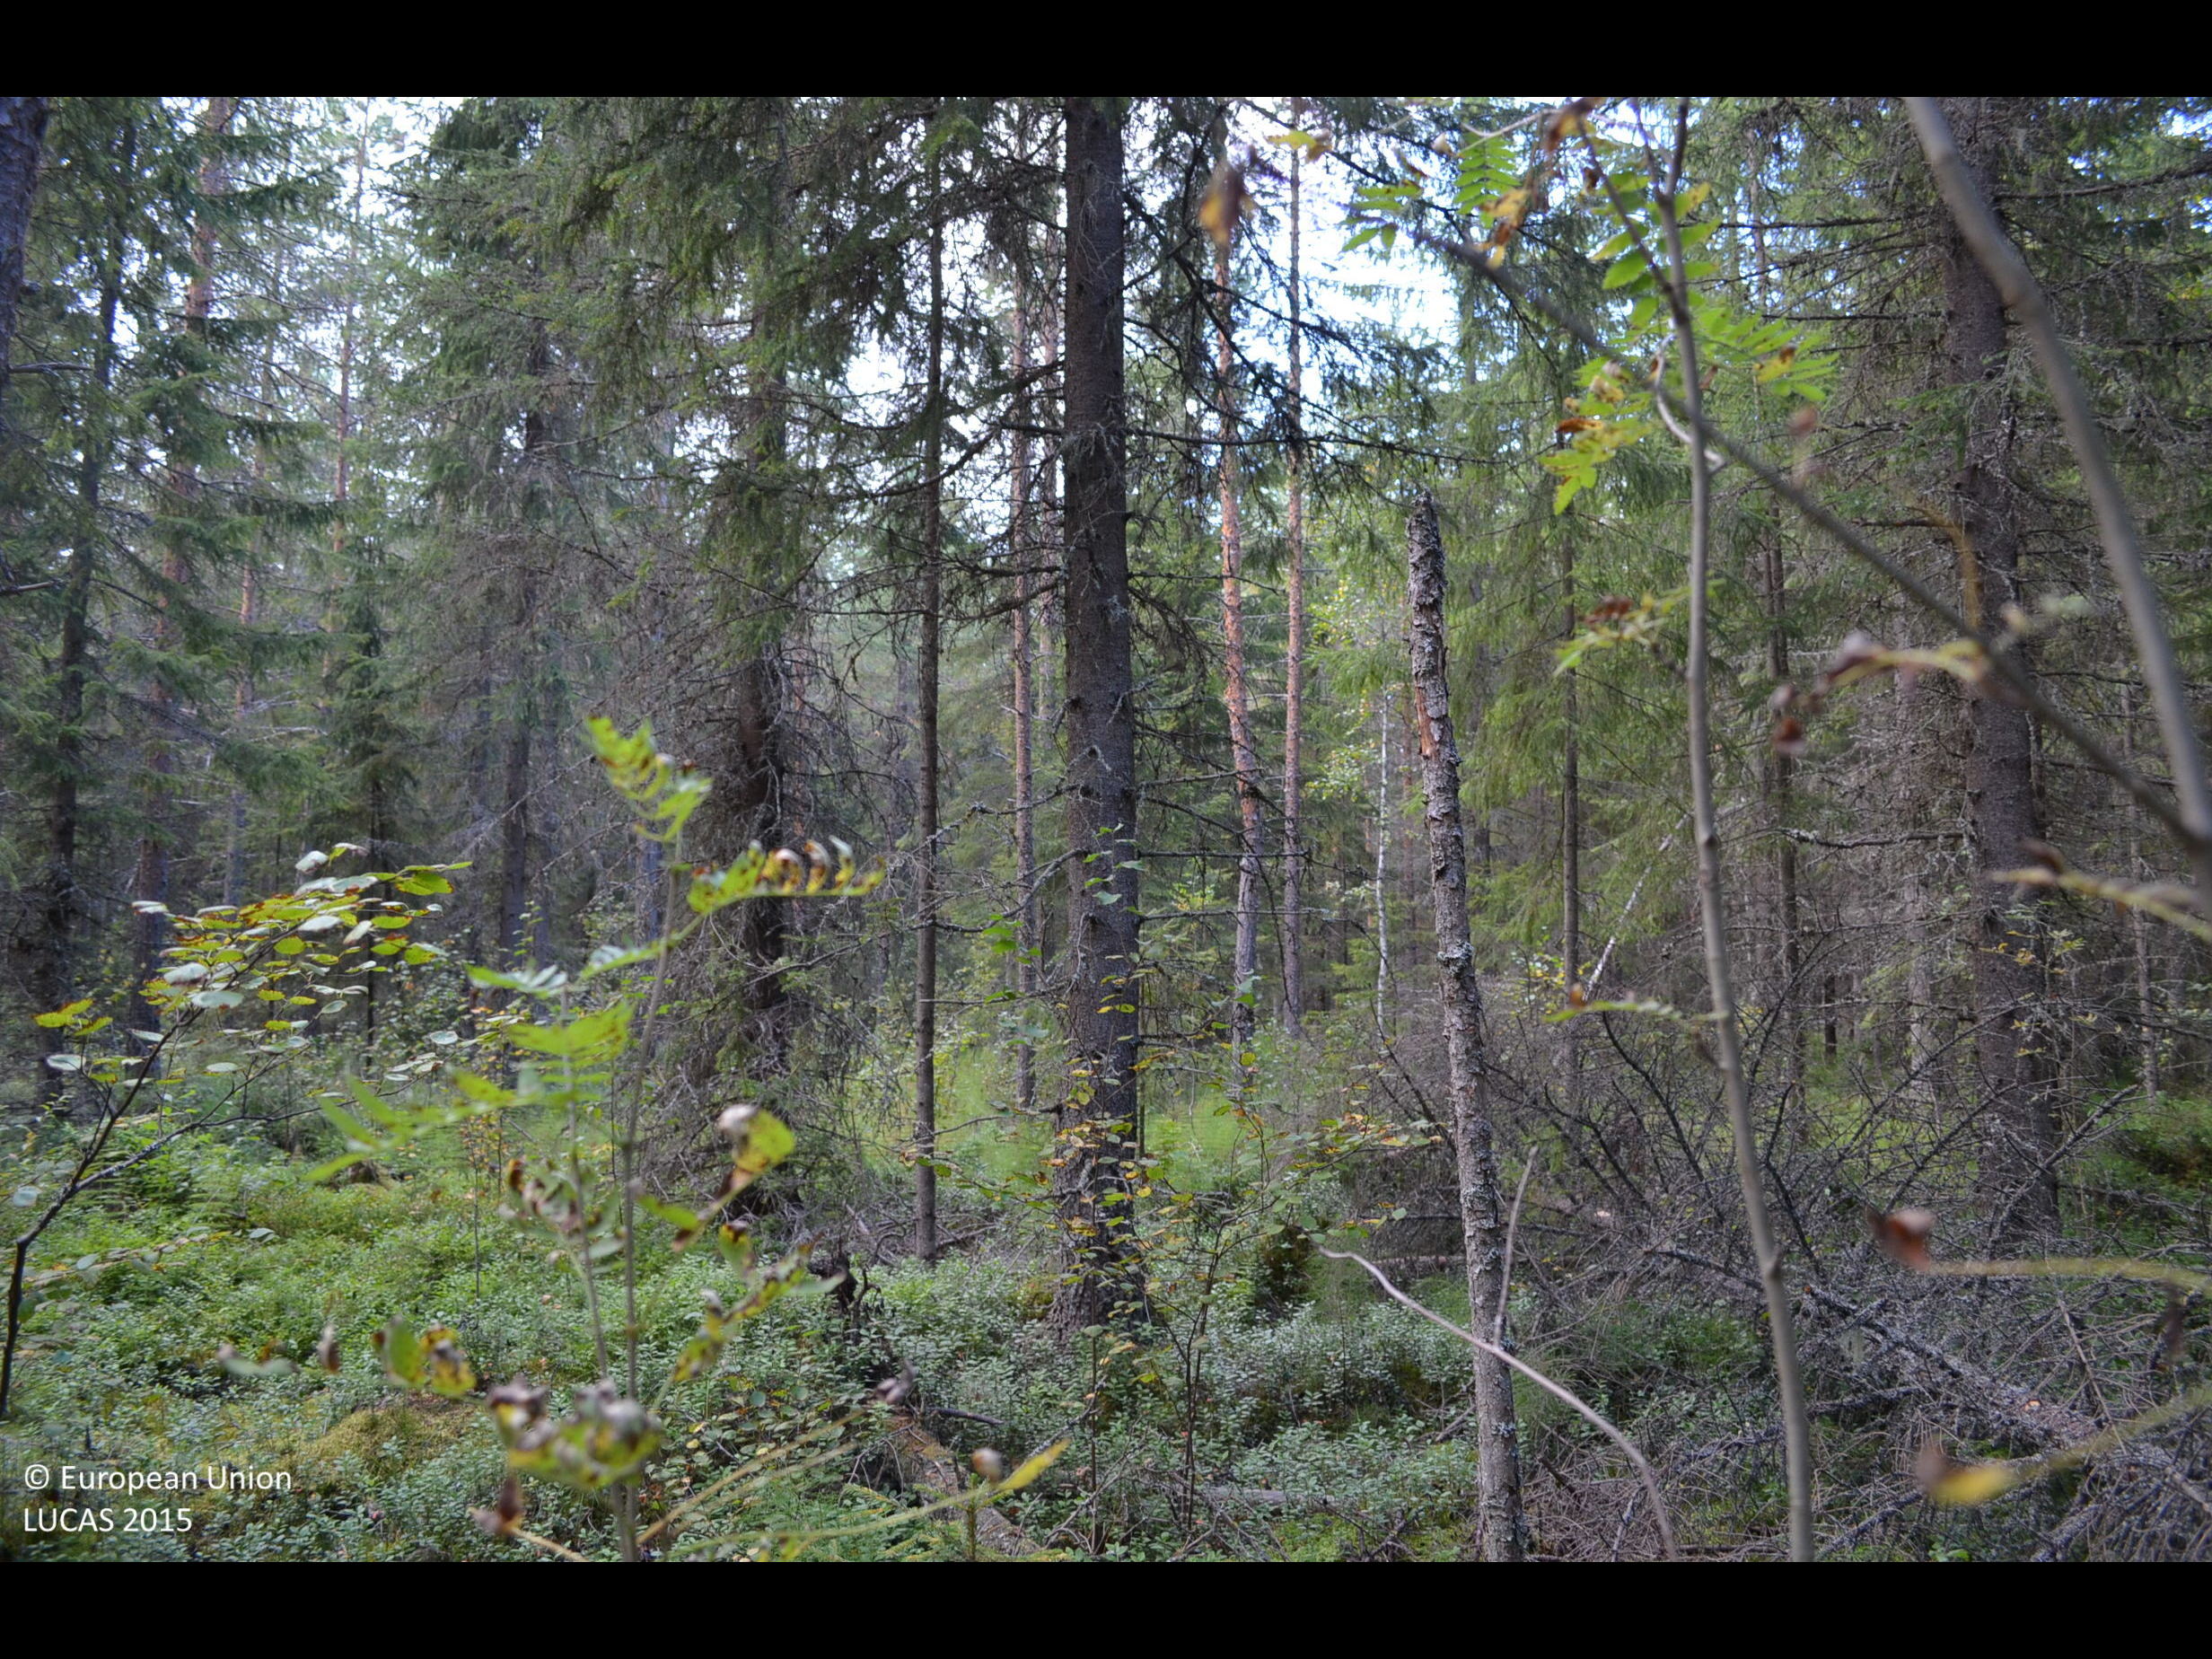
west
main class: Woodland
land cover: Other coniferous woodland
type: boreal forest
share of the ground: > 75 %
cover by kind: coniferous forest trees 70 %, shrubs 15 %, broadleaved forest trees 5 %, herbaceous plants 5 %, lichens and mosses 5 %
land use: Forestry
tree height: > 5 m
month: August
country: FI
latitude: 62.3779
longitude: 23.5878
